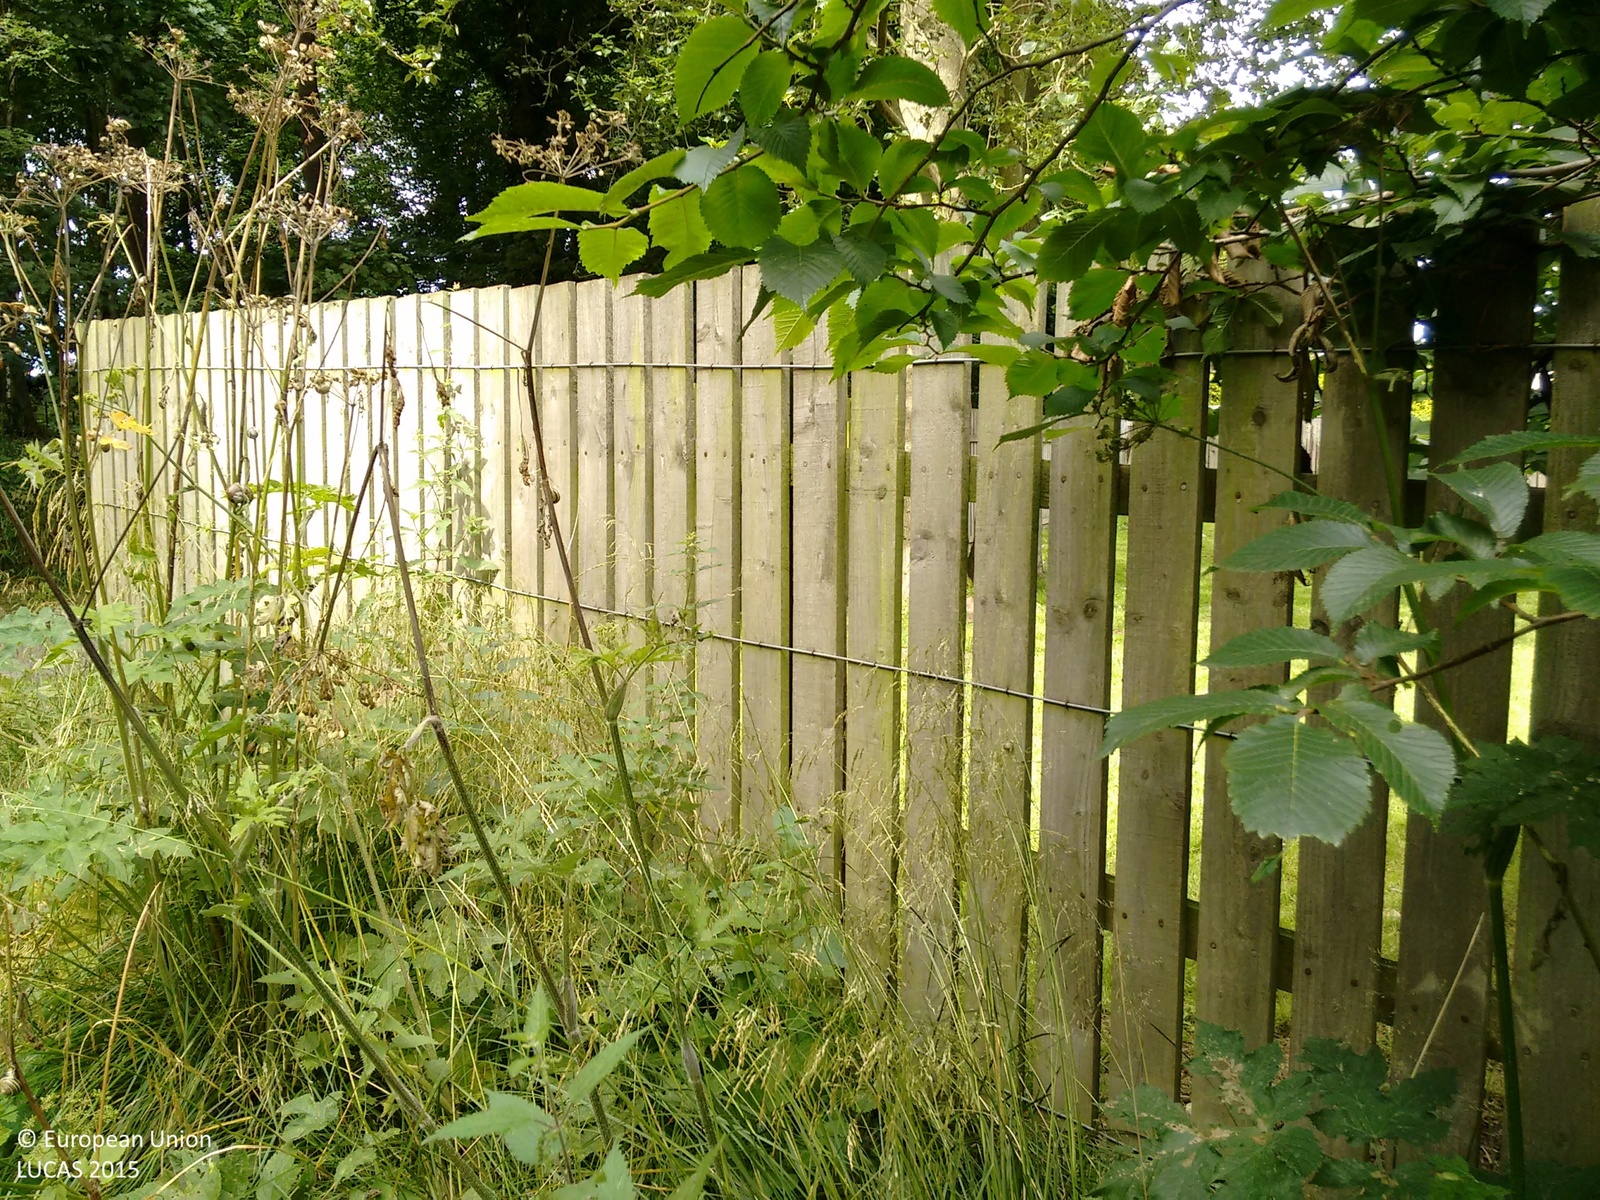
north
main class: Woodland
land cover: Broadleaved woodland
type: mesophytic deciduous forest
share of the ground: > 75 %
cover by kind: broadleaved forest trees 60 %, herbaceous plants 30 %, consolidated bare surface 10 %
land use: Residential
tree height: > 5 m
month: August
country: GB
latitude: 57.1779
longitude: -2.1071
